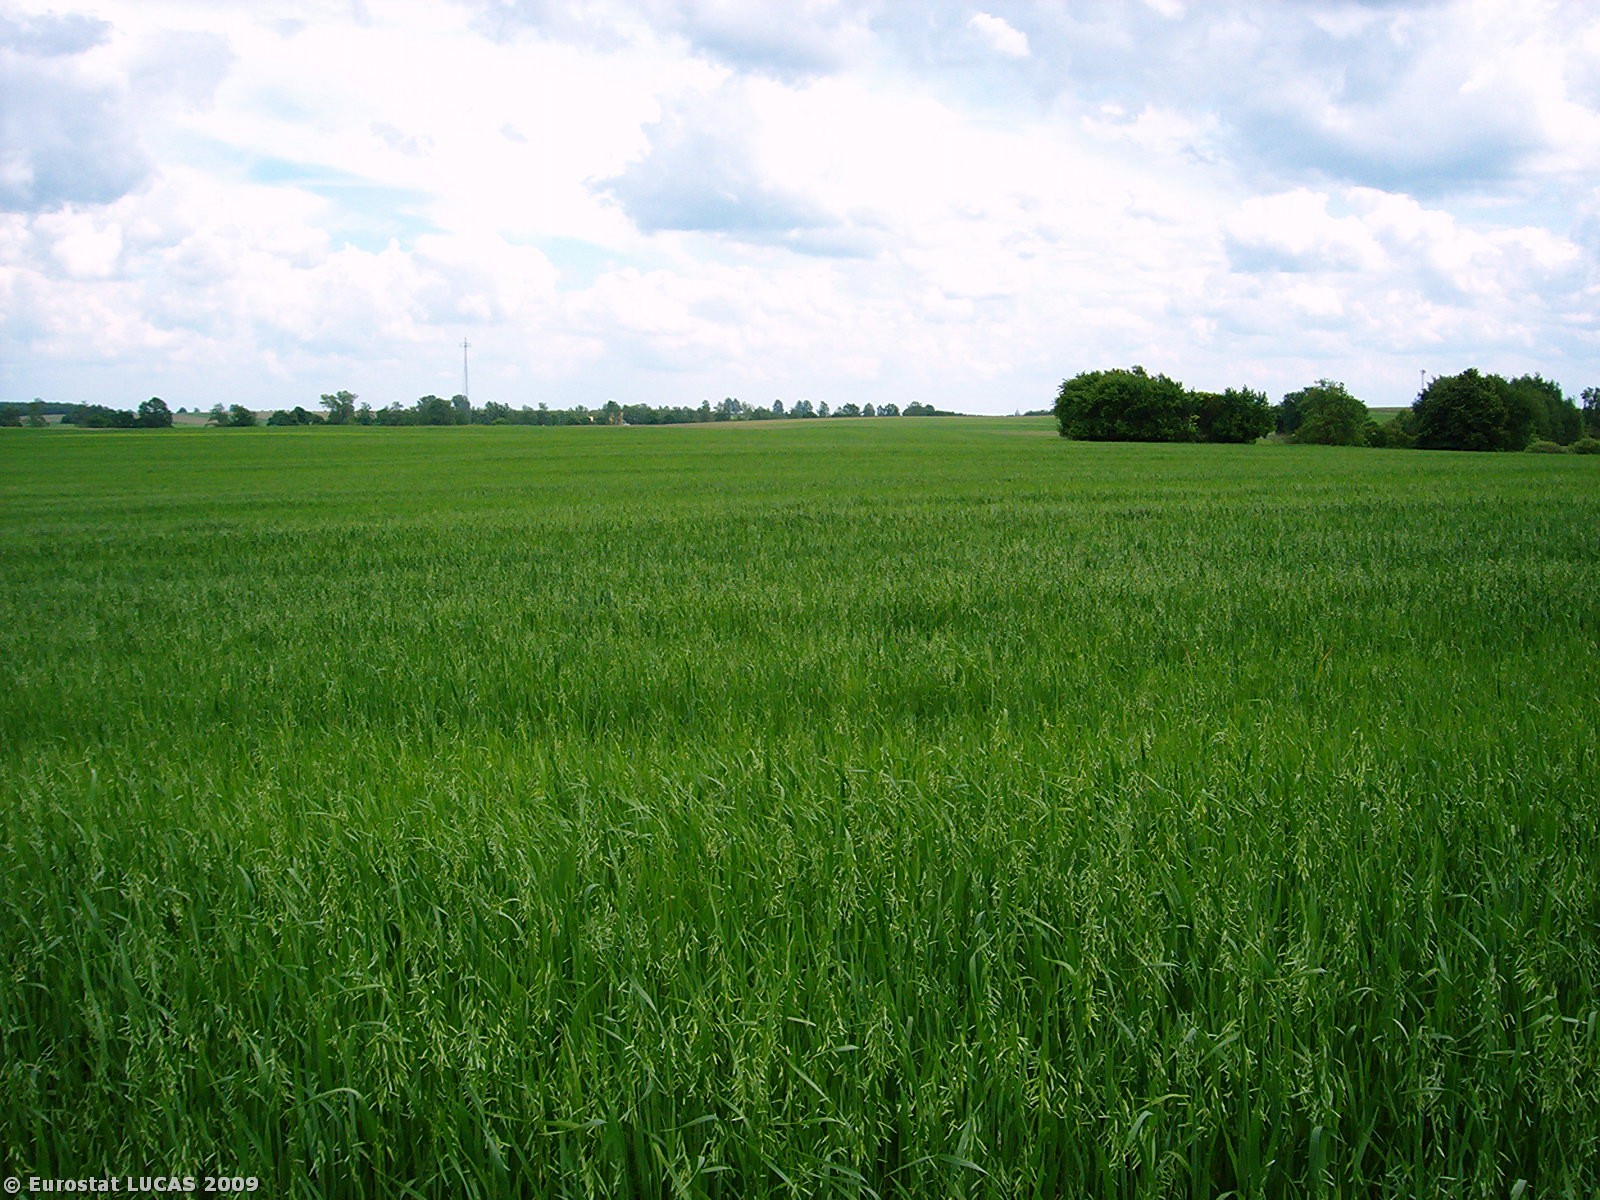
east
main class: Cropland
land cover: Oats
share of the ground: > 75 %
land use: Agriculture (excluding fallow land and kitchen gardens)
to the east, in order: Oats
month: June
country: PL
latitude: 53.6230
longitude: 17.1612
